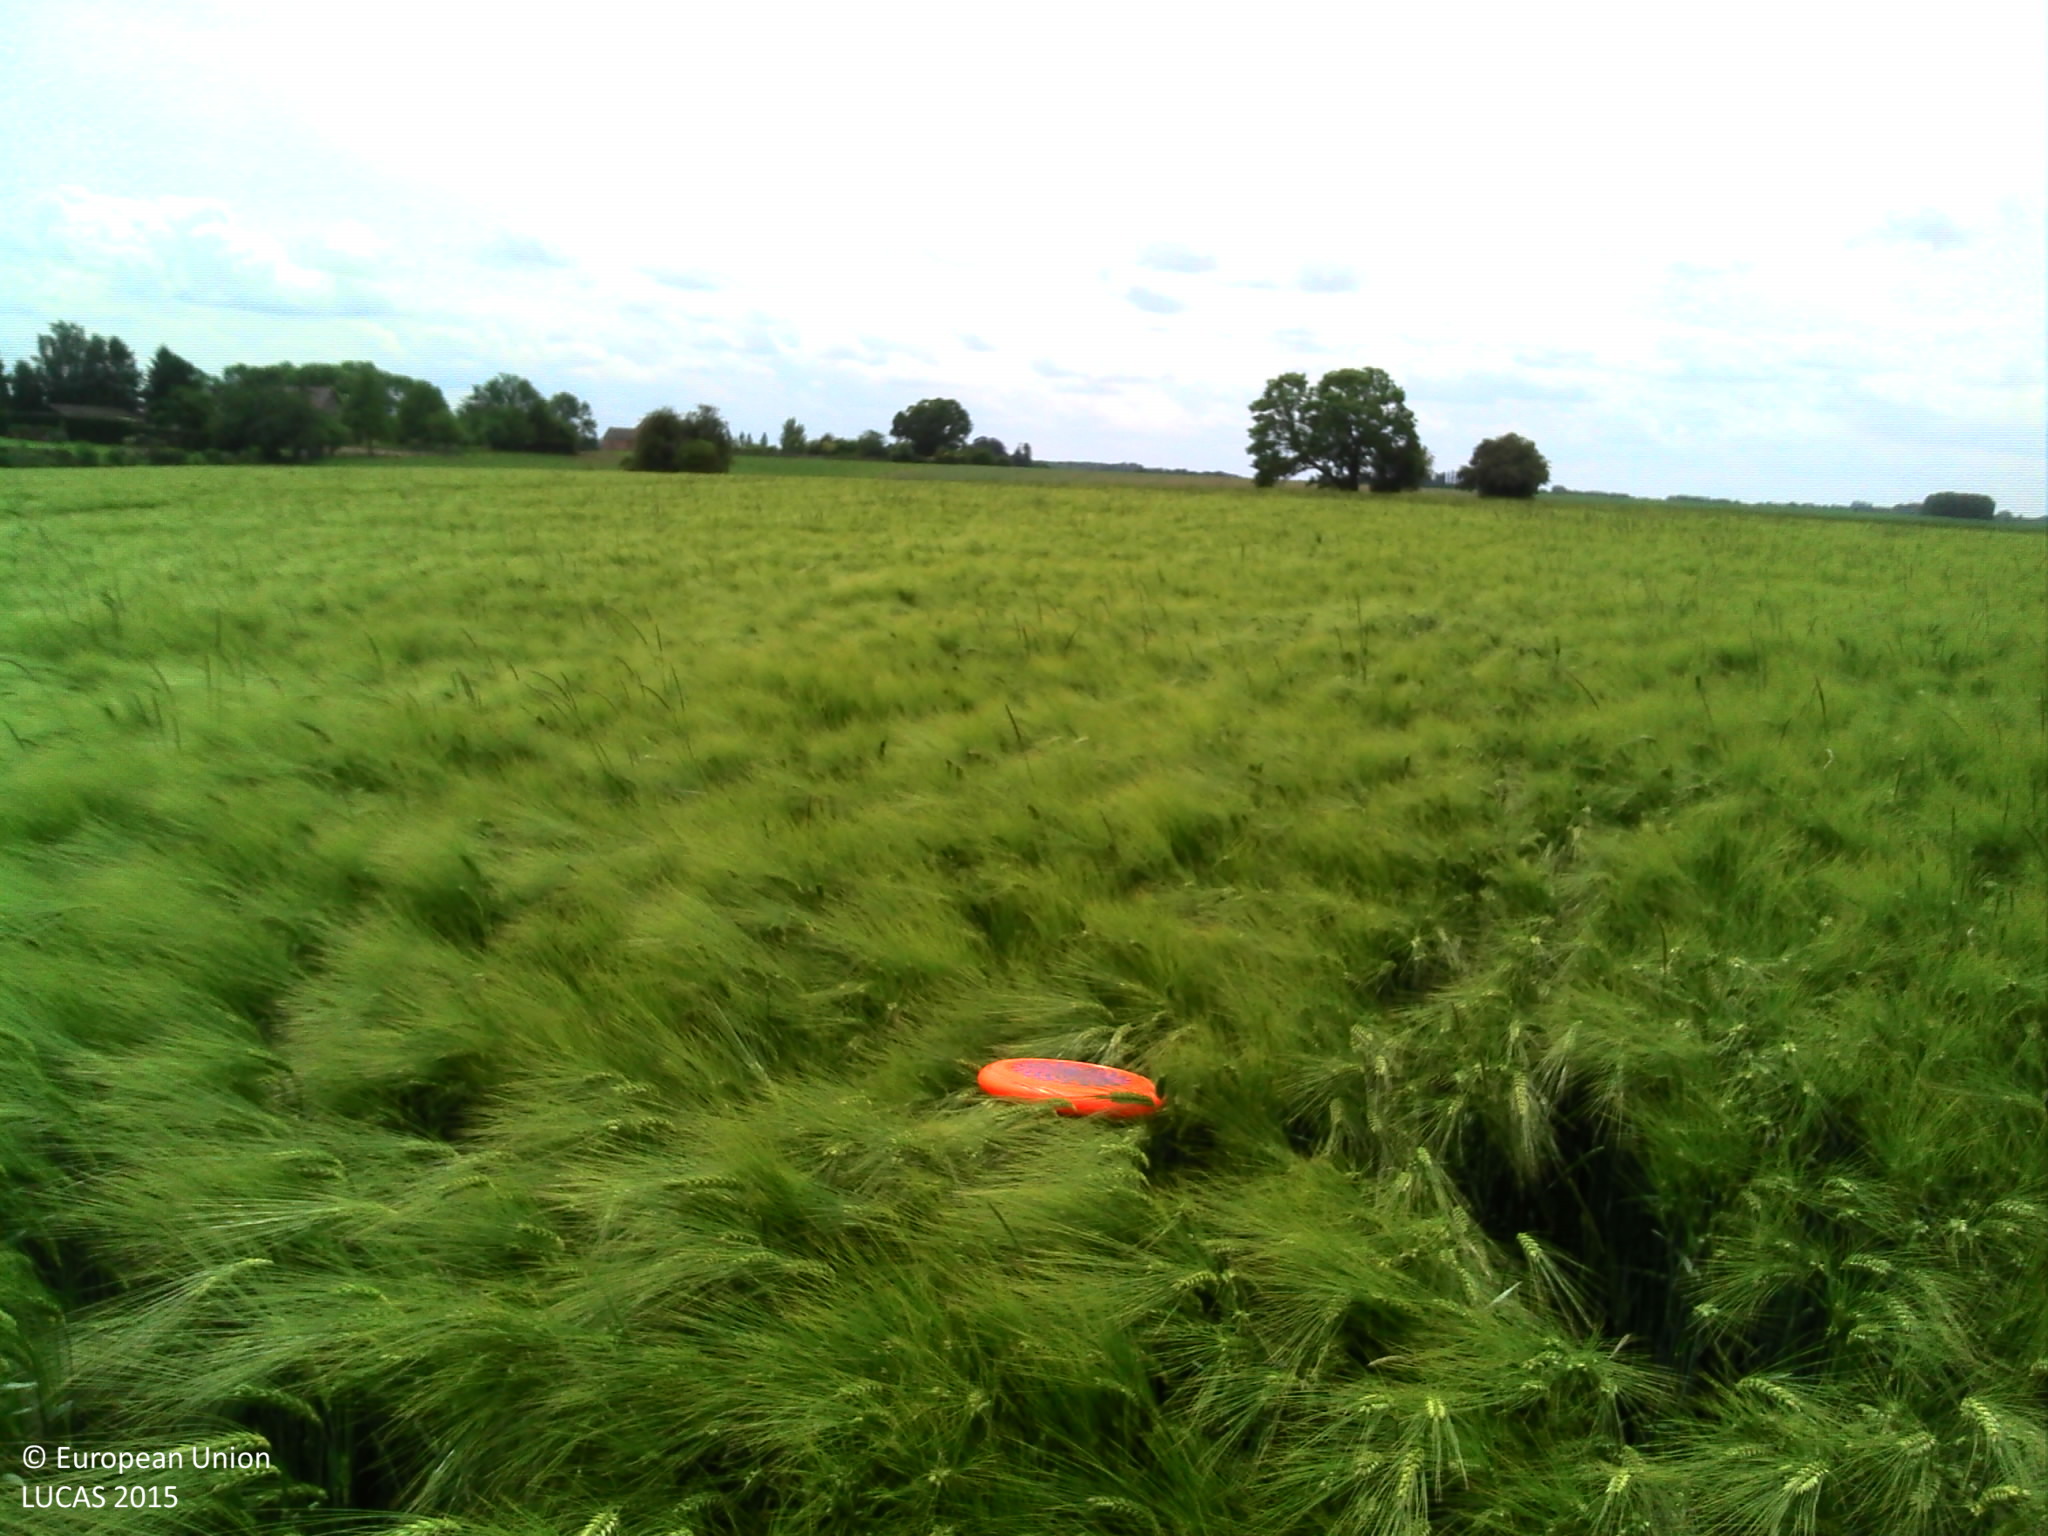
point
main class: Cropland
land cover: Barley
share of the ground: > 75 %
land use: Agriculture (excluding fallow land and kitchen gardens)
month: May
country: BE
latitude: 50.6592
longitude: 4.7767
